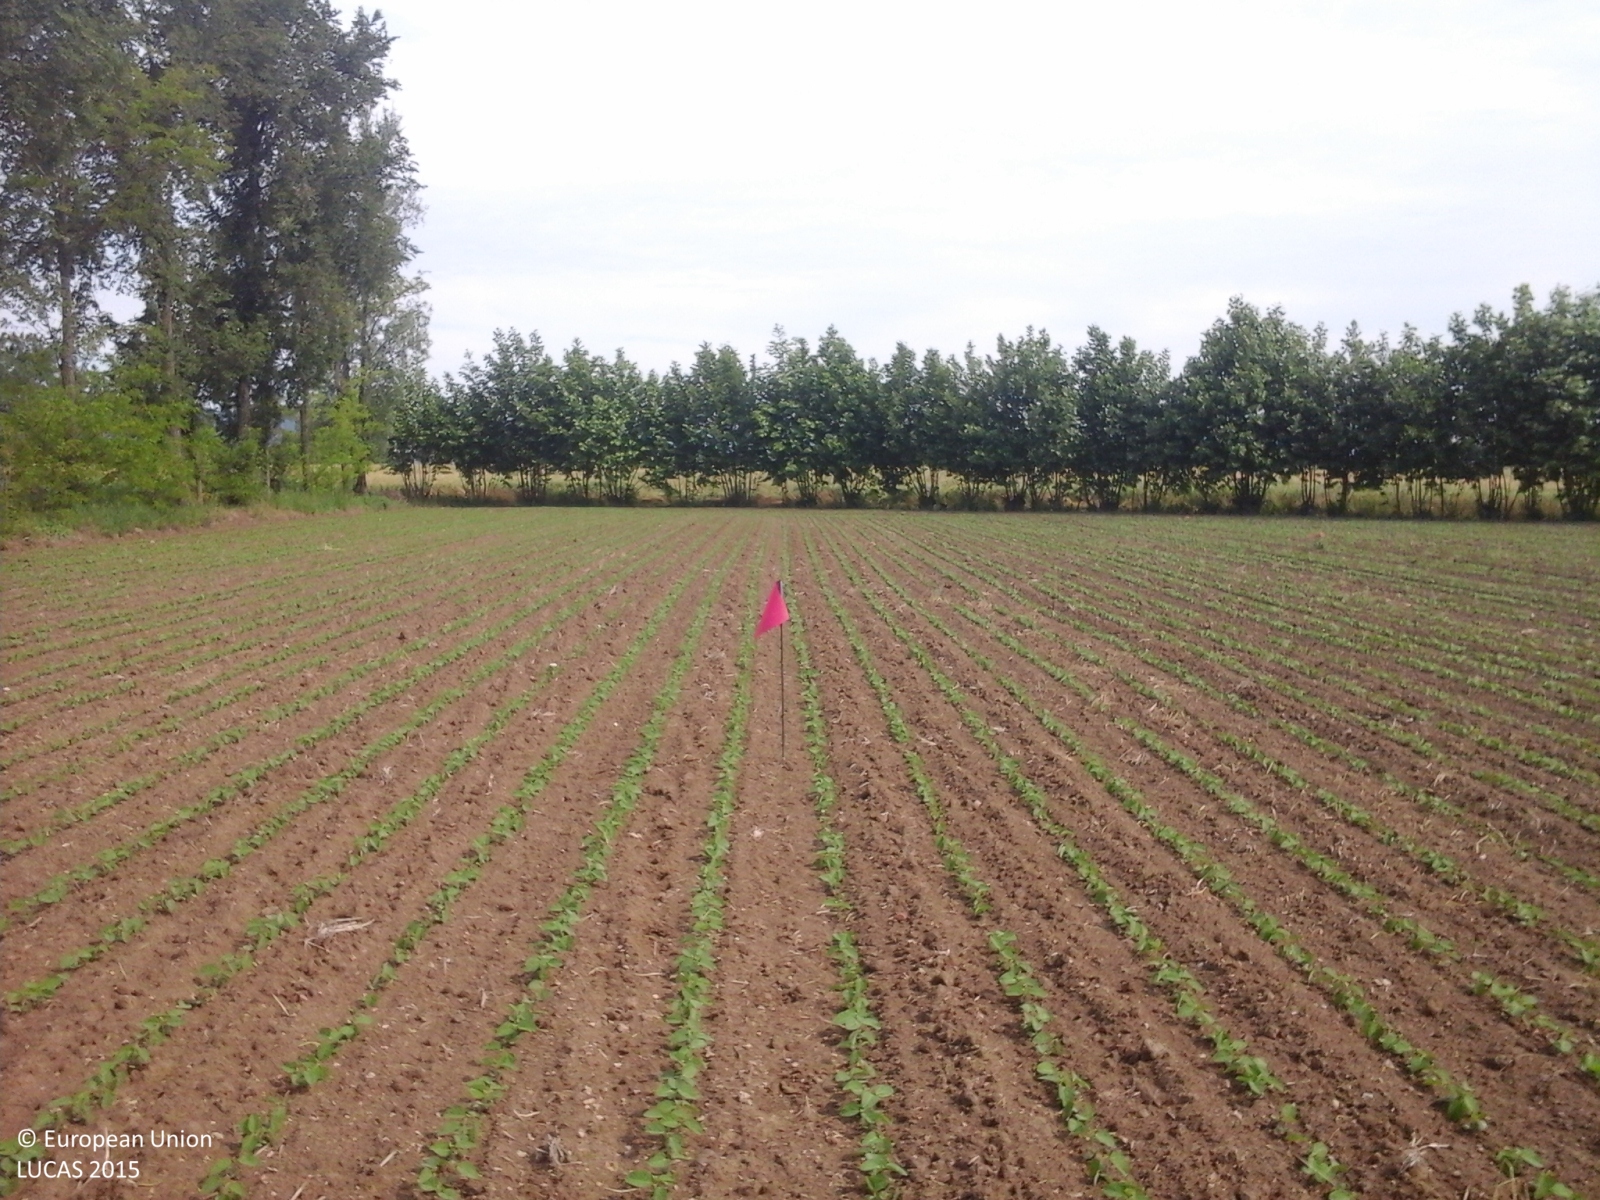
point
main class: Cropland
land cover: Soya
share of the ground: < 10 %
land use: Agriculture (excluding fallow land and kitchen gardens)
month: May
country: IT
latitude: 45.4019
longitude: 11.6198
